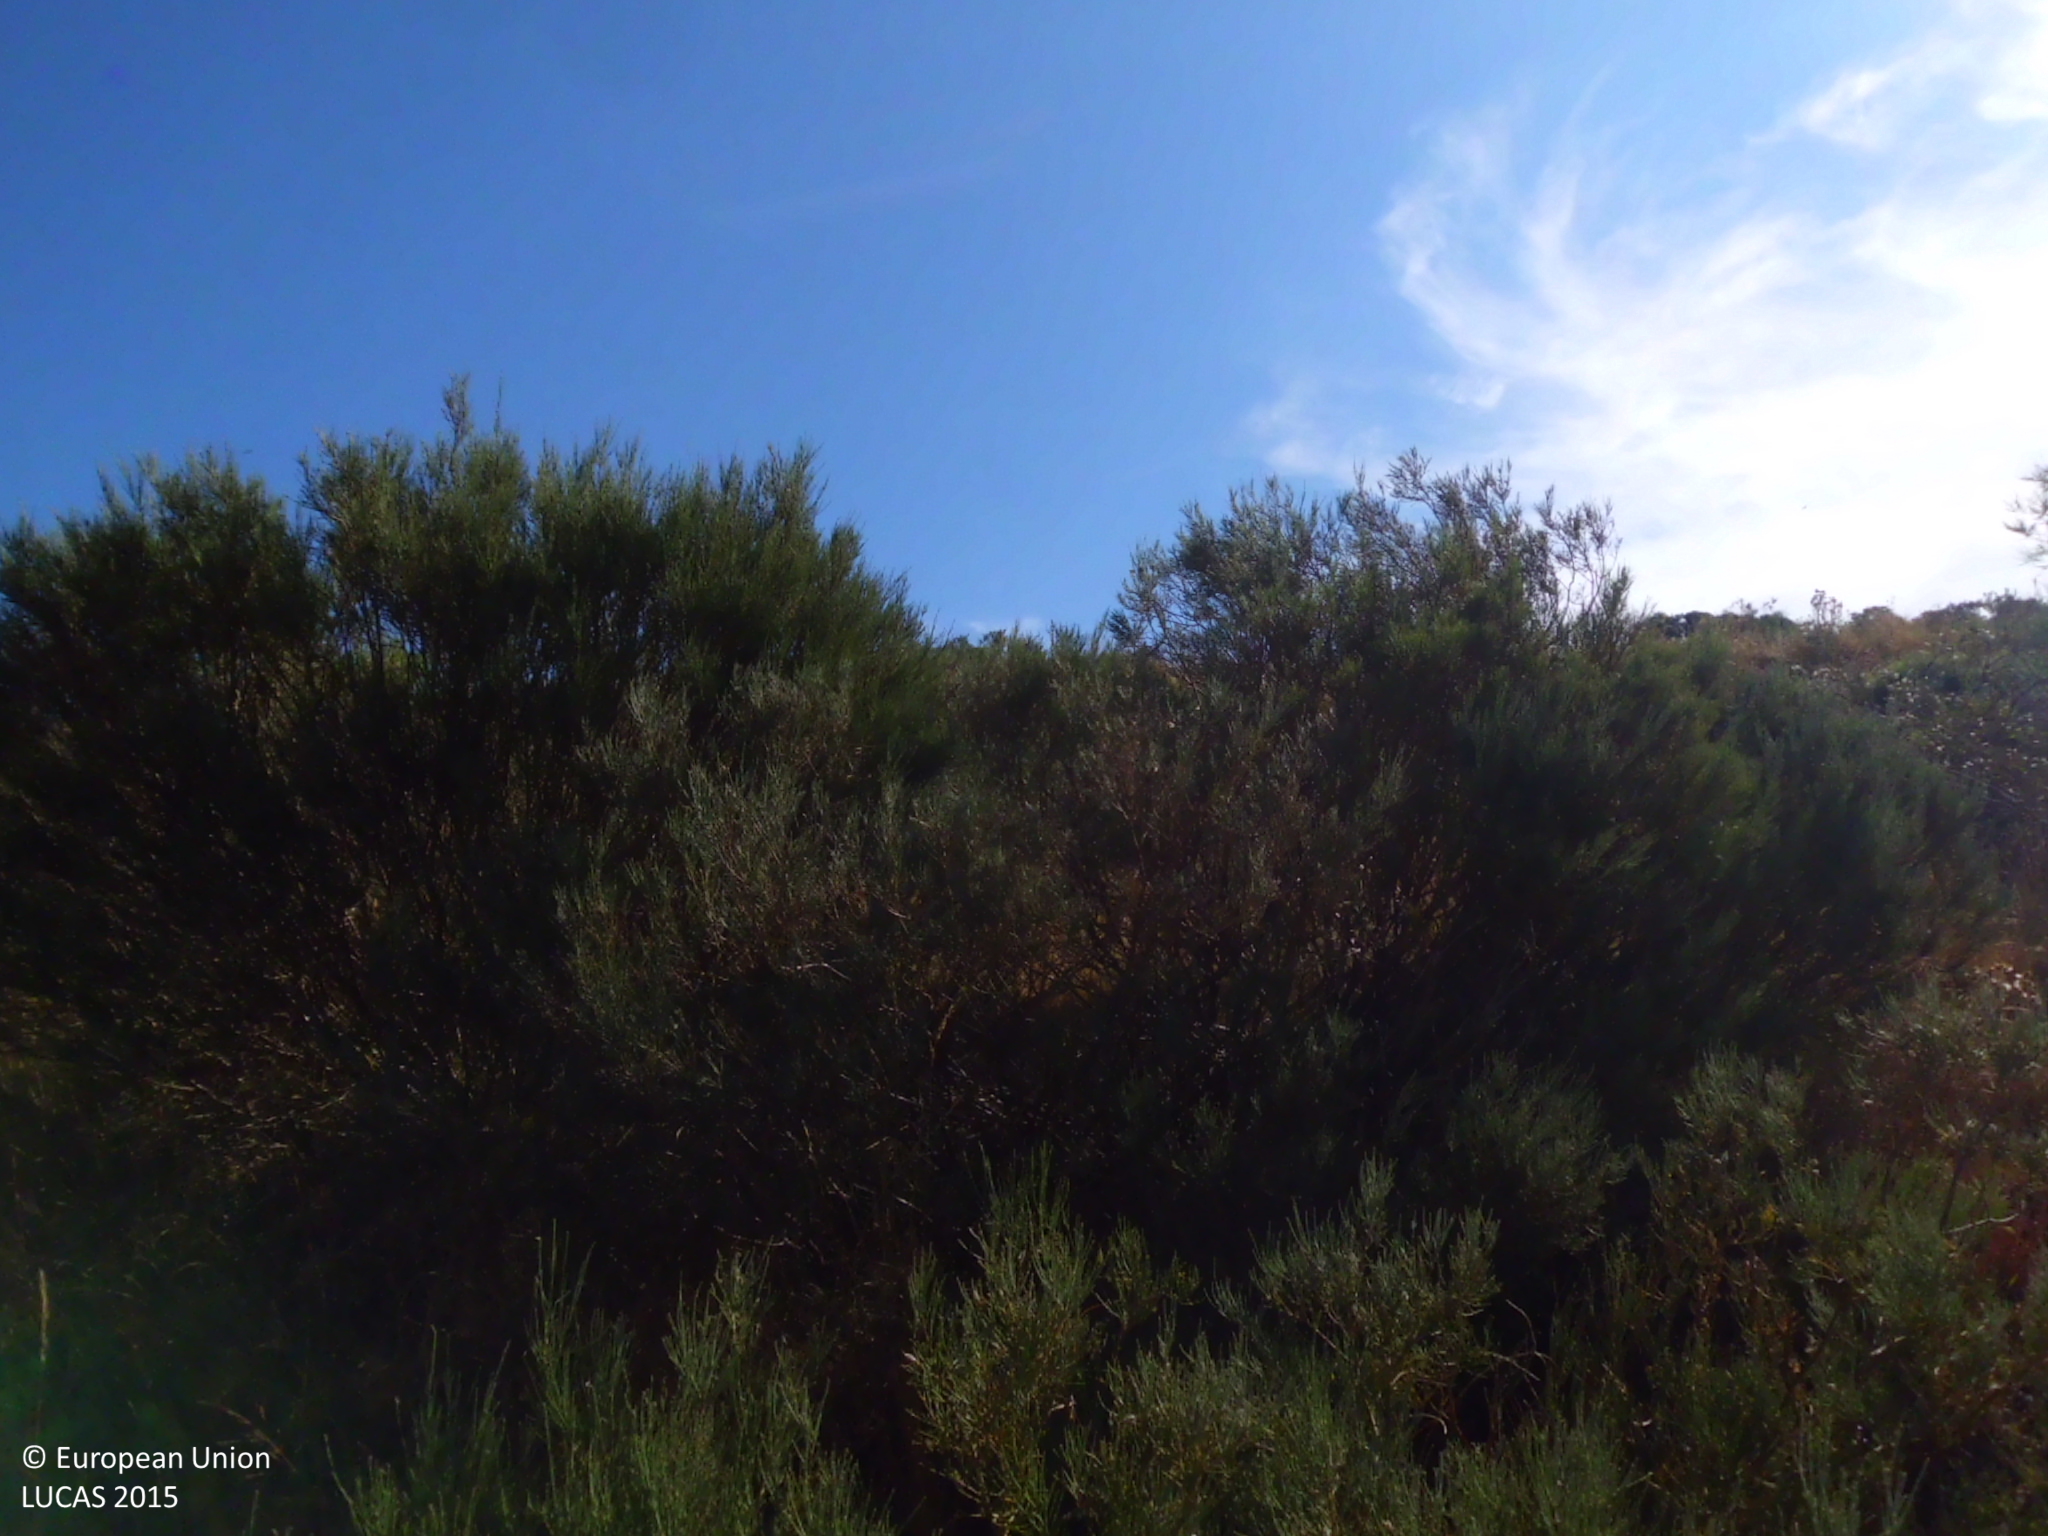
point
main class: Shrubland
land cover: Shrubland with sparse tree cover
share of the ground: > 75 %
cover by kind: shrubs 90 %, broadleaved forest trees 5 %, herbaceous plants 5 %
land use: Semi-natural and natural areas not in use
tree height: < 5 m
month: July
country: ES
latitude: 43.0148
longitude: -4.4980
